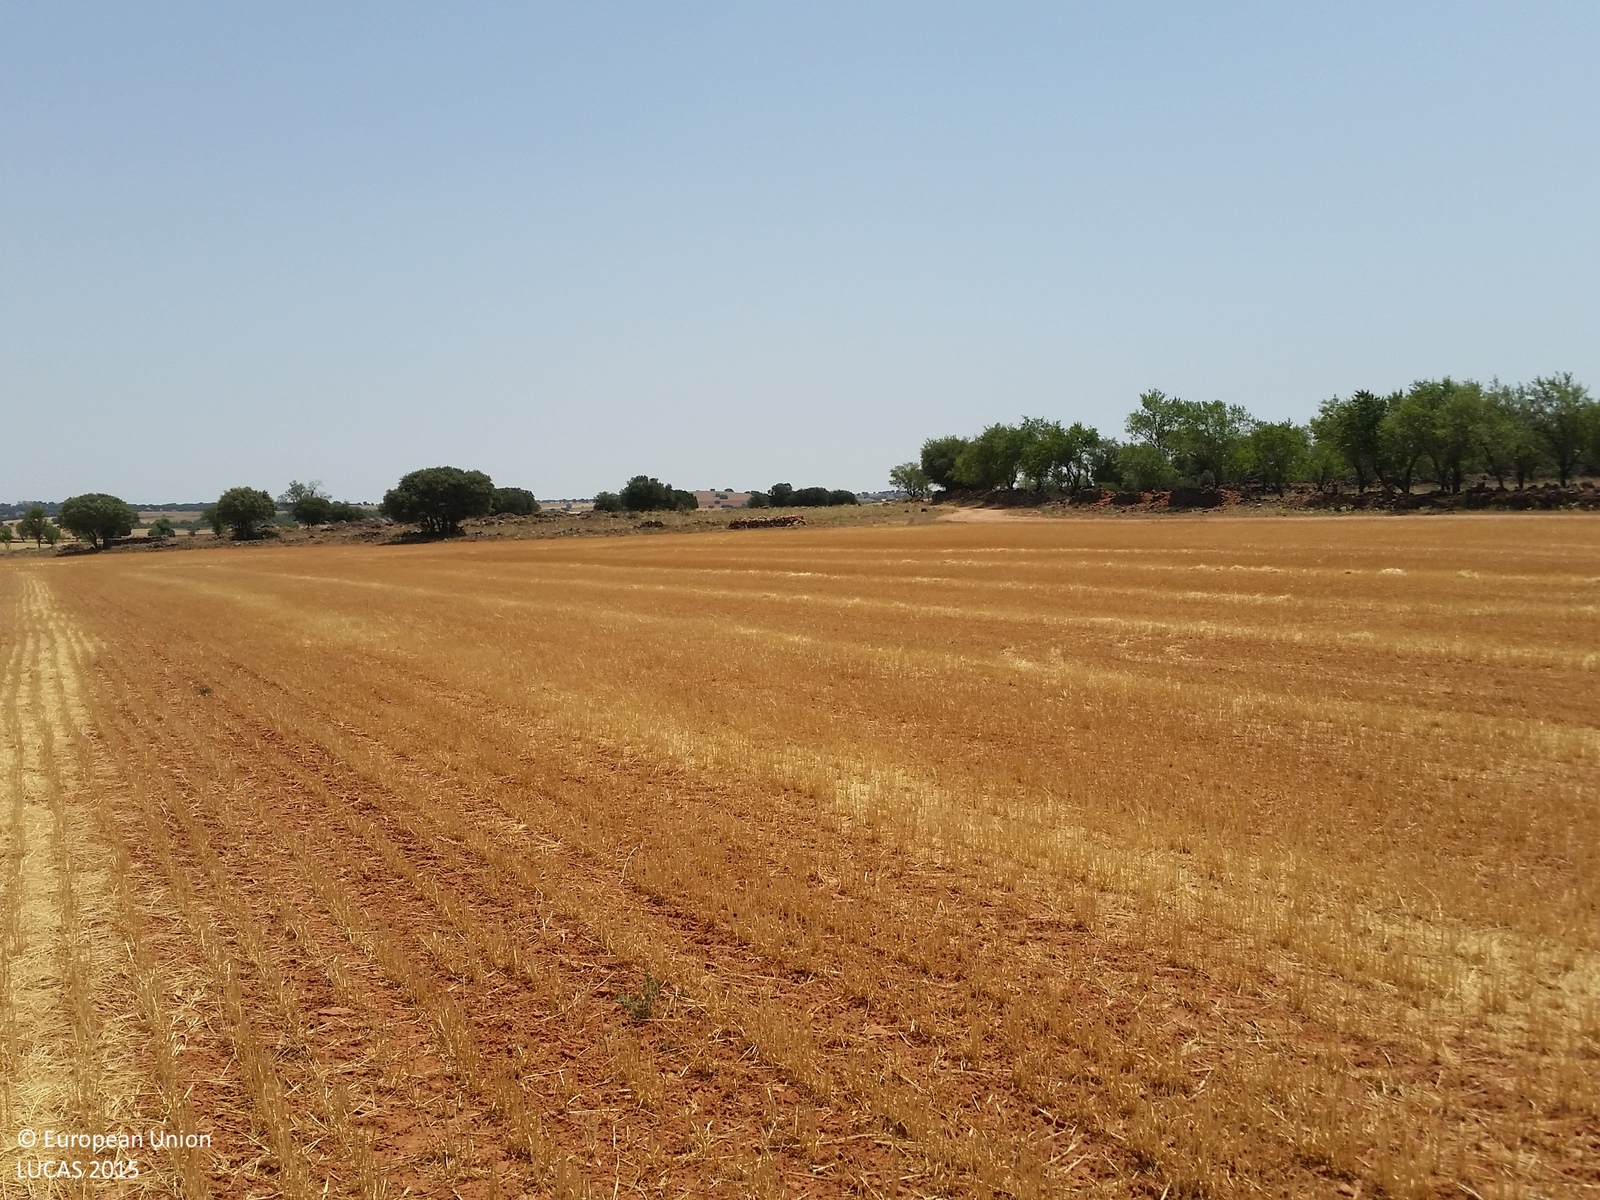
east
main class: Cropland
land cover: Barley
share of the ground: < 10 %
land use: Agriculture (excluding fallow land and kitchen gardens)
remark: Harvested field
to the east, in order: Barley; Grassland without tree/shrub cover; Dry stone walls; Grassland without tree/shrub cover; Dry stone walls; Grassland without tree/shrub cover; Dry stone walls; Grassland without tree/shrub cover
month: June
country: ES
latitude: 38.7795
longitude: -2.5618
